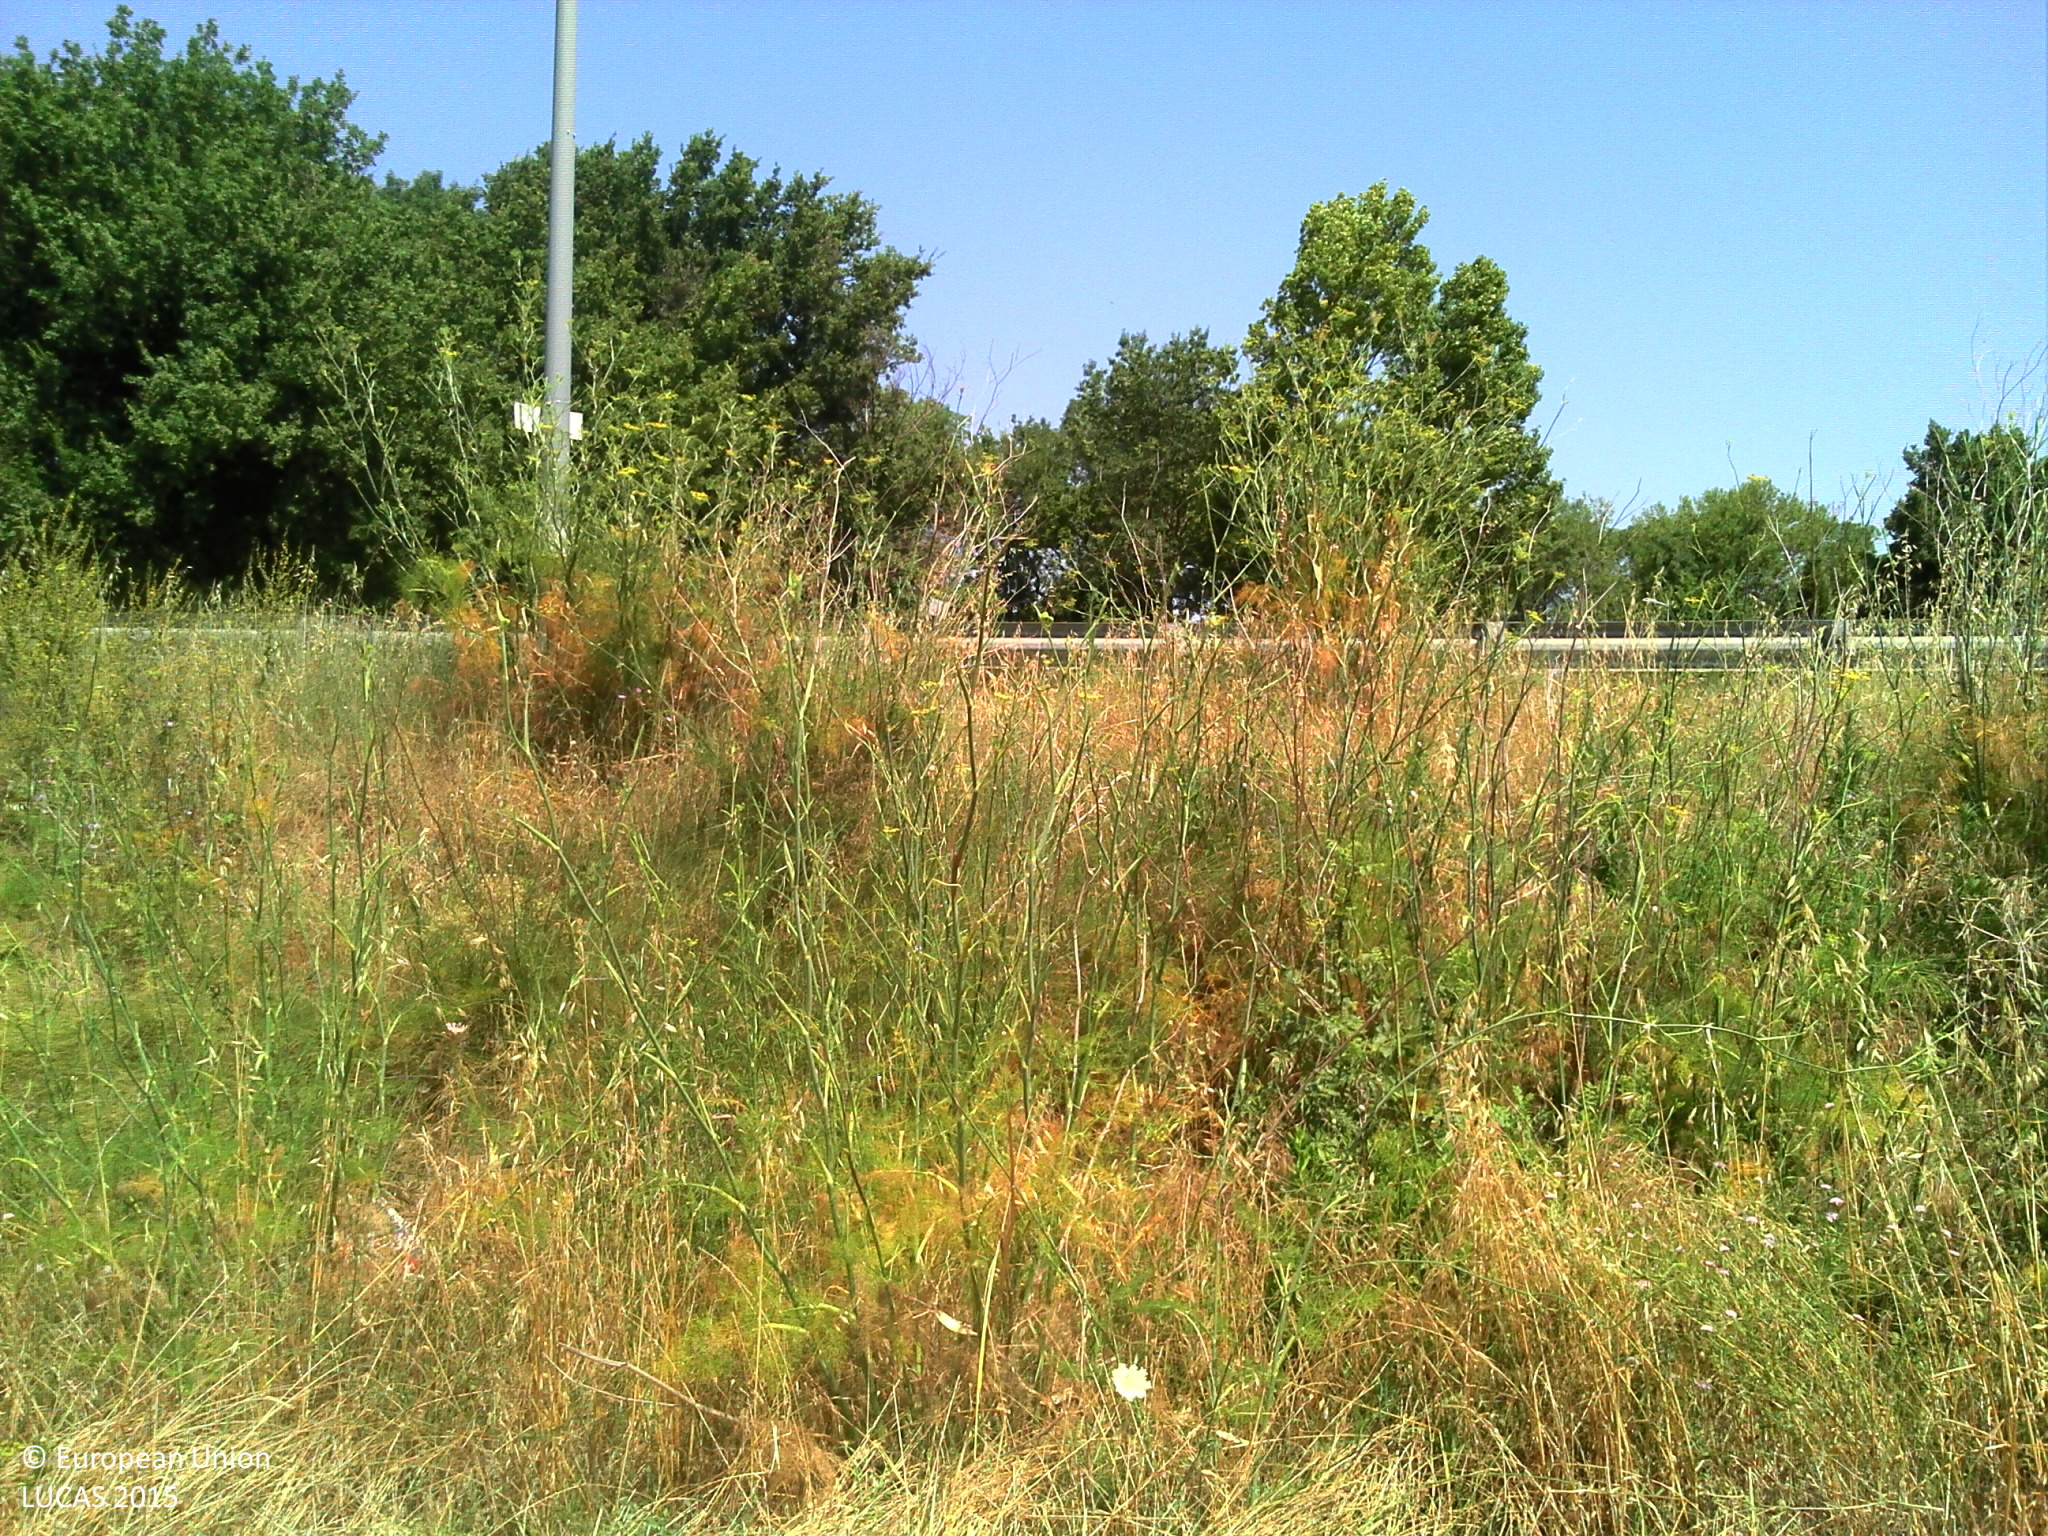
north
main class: Cropland
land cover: Common wheat
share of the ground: > 75 %
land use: Agriculture (excluding fallow land and kitchen gardens)
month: July
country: FR
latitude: 43.4855
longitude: 5.7191
